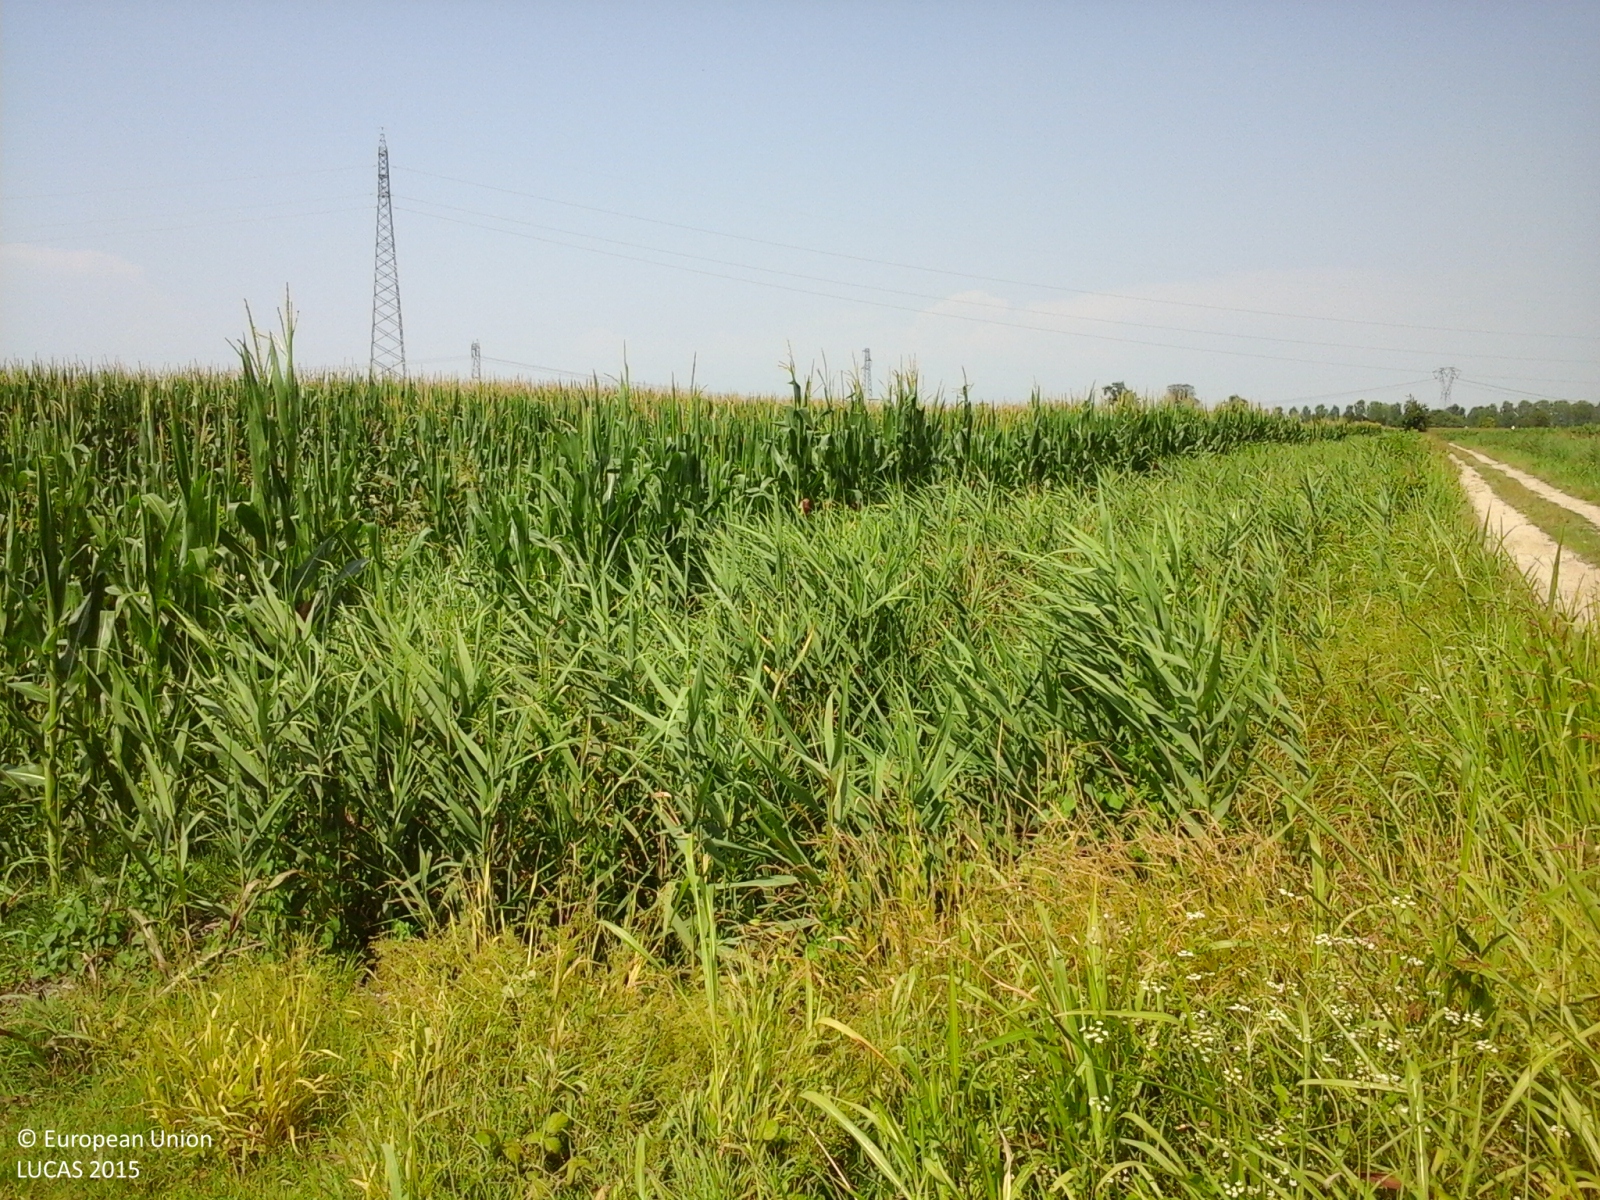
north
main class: Cropland
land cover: Maize
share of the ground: > 75 %
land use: Agriculture (excluding fallow land and kitchen gardens)
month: July
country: IT
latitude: 45.3025
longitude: 10.8784
